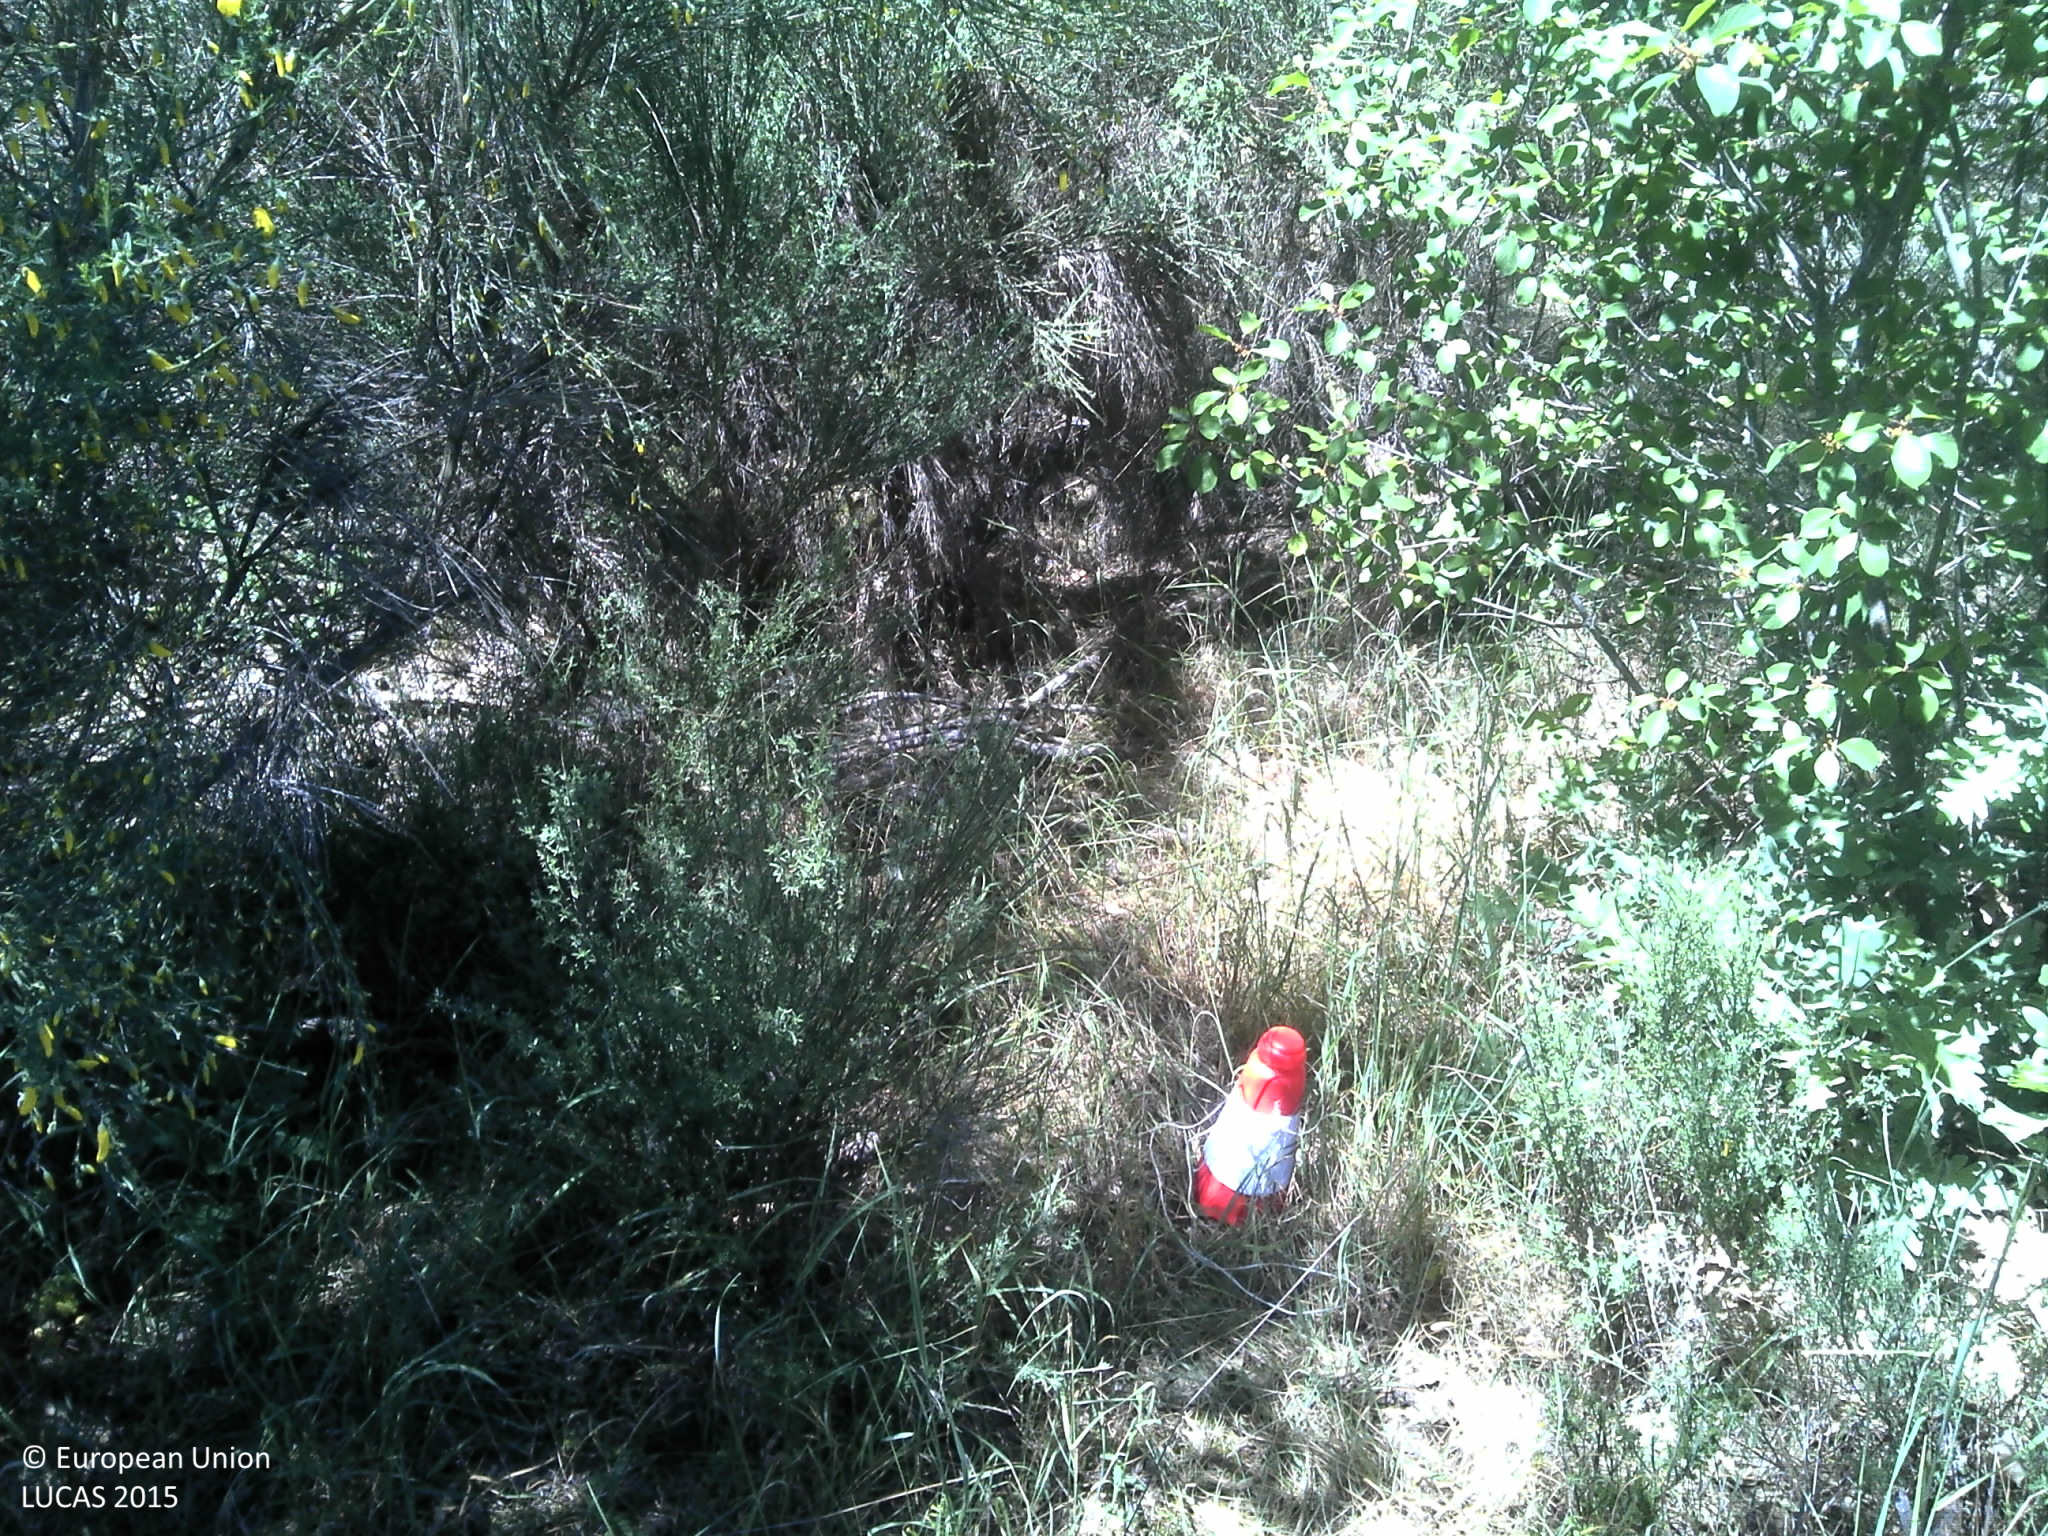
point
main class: Shrubland
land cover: Shrubland with sparse tree cover
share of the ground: 50 - 75 %
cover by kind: shrubs 65 %, herbaceous plants 15 %, unconsolidated bare surface 10 %, broadleaved forest trees 5 %
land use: Semi-natural and natural areas not in use
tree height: > 5 m
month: May
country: PT
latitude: 40.5664
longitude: -7.1715
